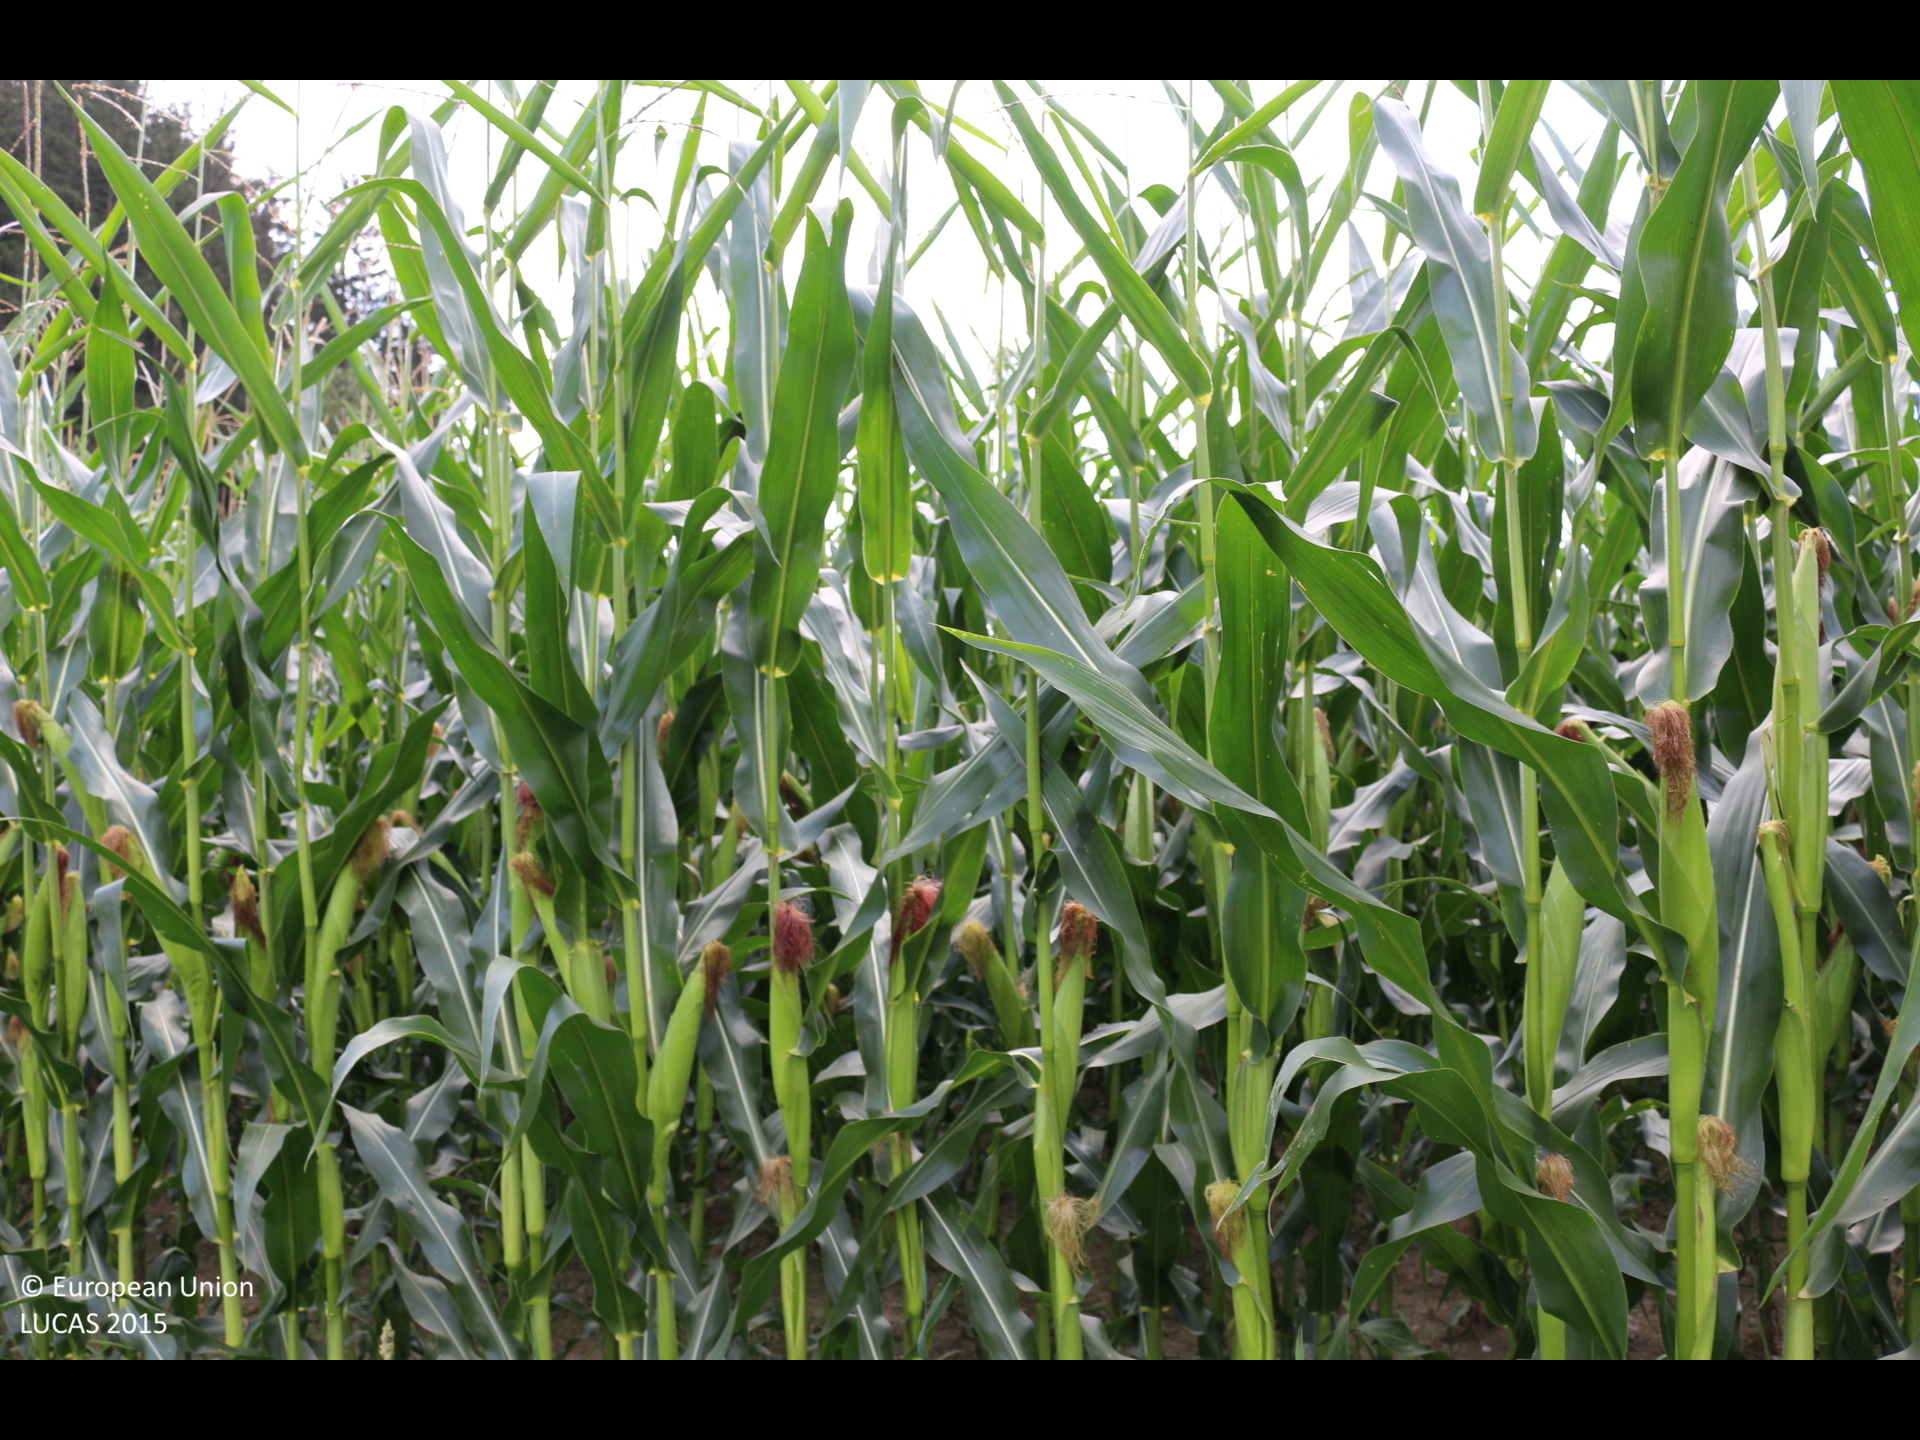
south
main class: Cropland
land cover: Maize
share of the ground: > 75 %
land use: Agriculture (excluding fallow land and kitchen gardens)
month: August
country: AT
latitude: 46.8665
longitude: 14.1301
